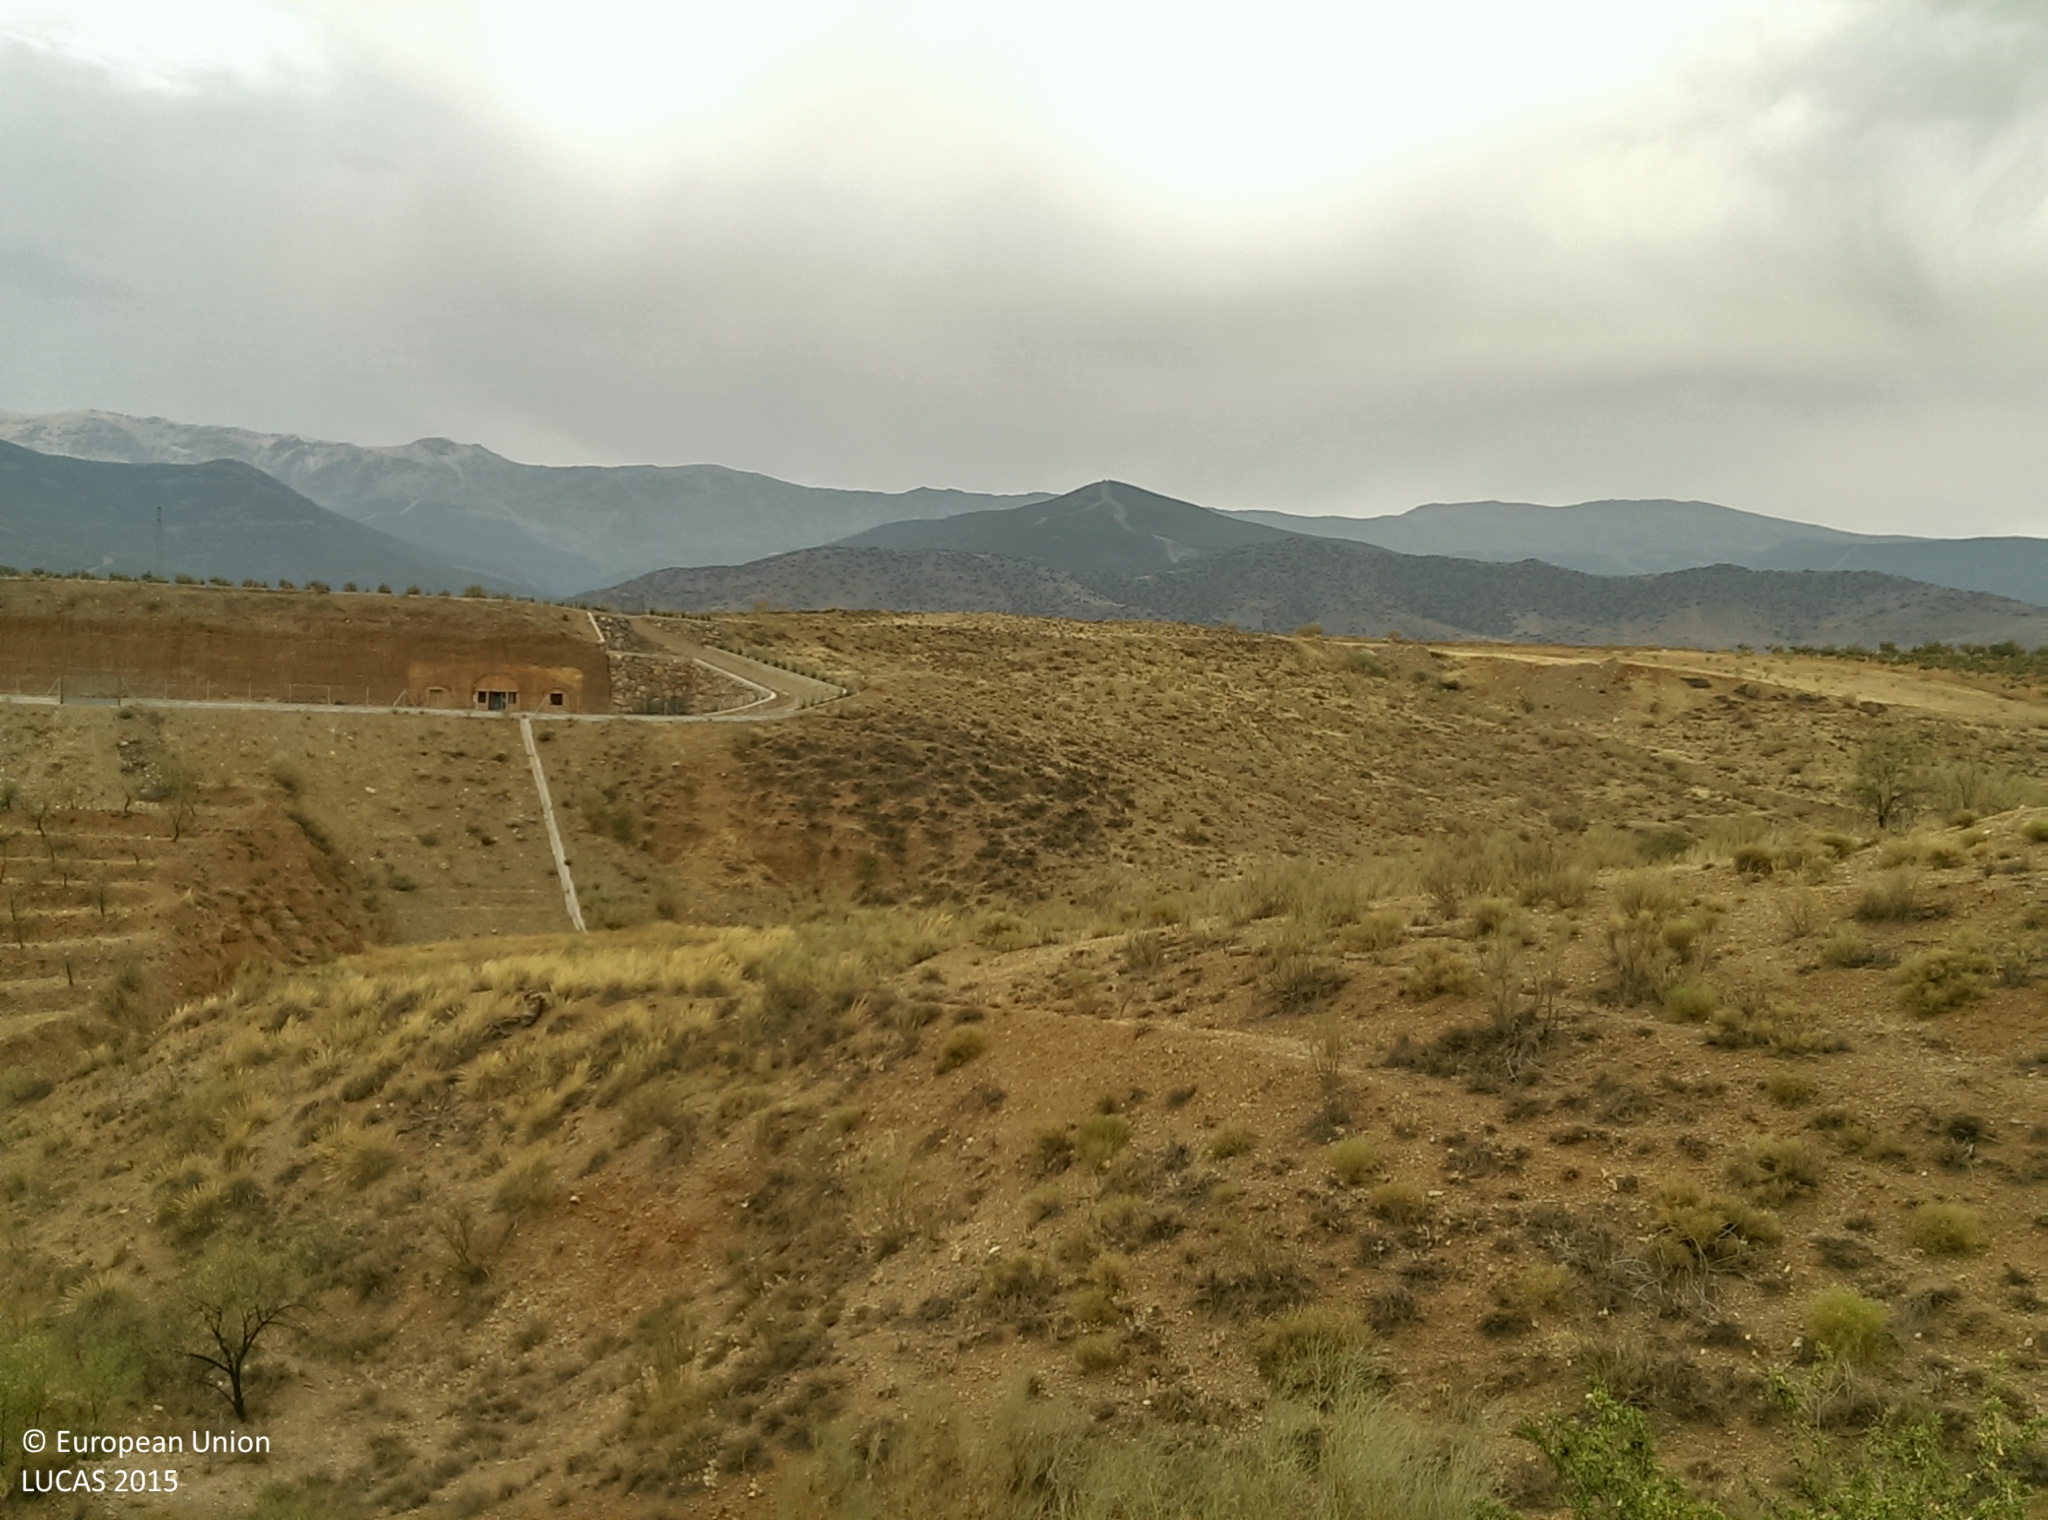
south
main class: Cropland
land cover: Nuts trees
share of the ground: < 10 %
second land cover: Spontaneously vegetated surfaces
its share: 10 - 25 %
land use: Agriculture (excluding fallow land and kitchen gardens)
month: July
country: ES
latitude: 37.1943
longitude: -2.9054
